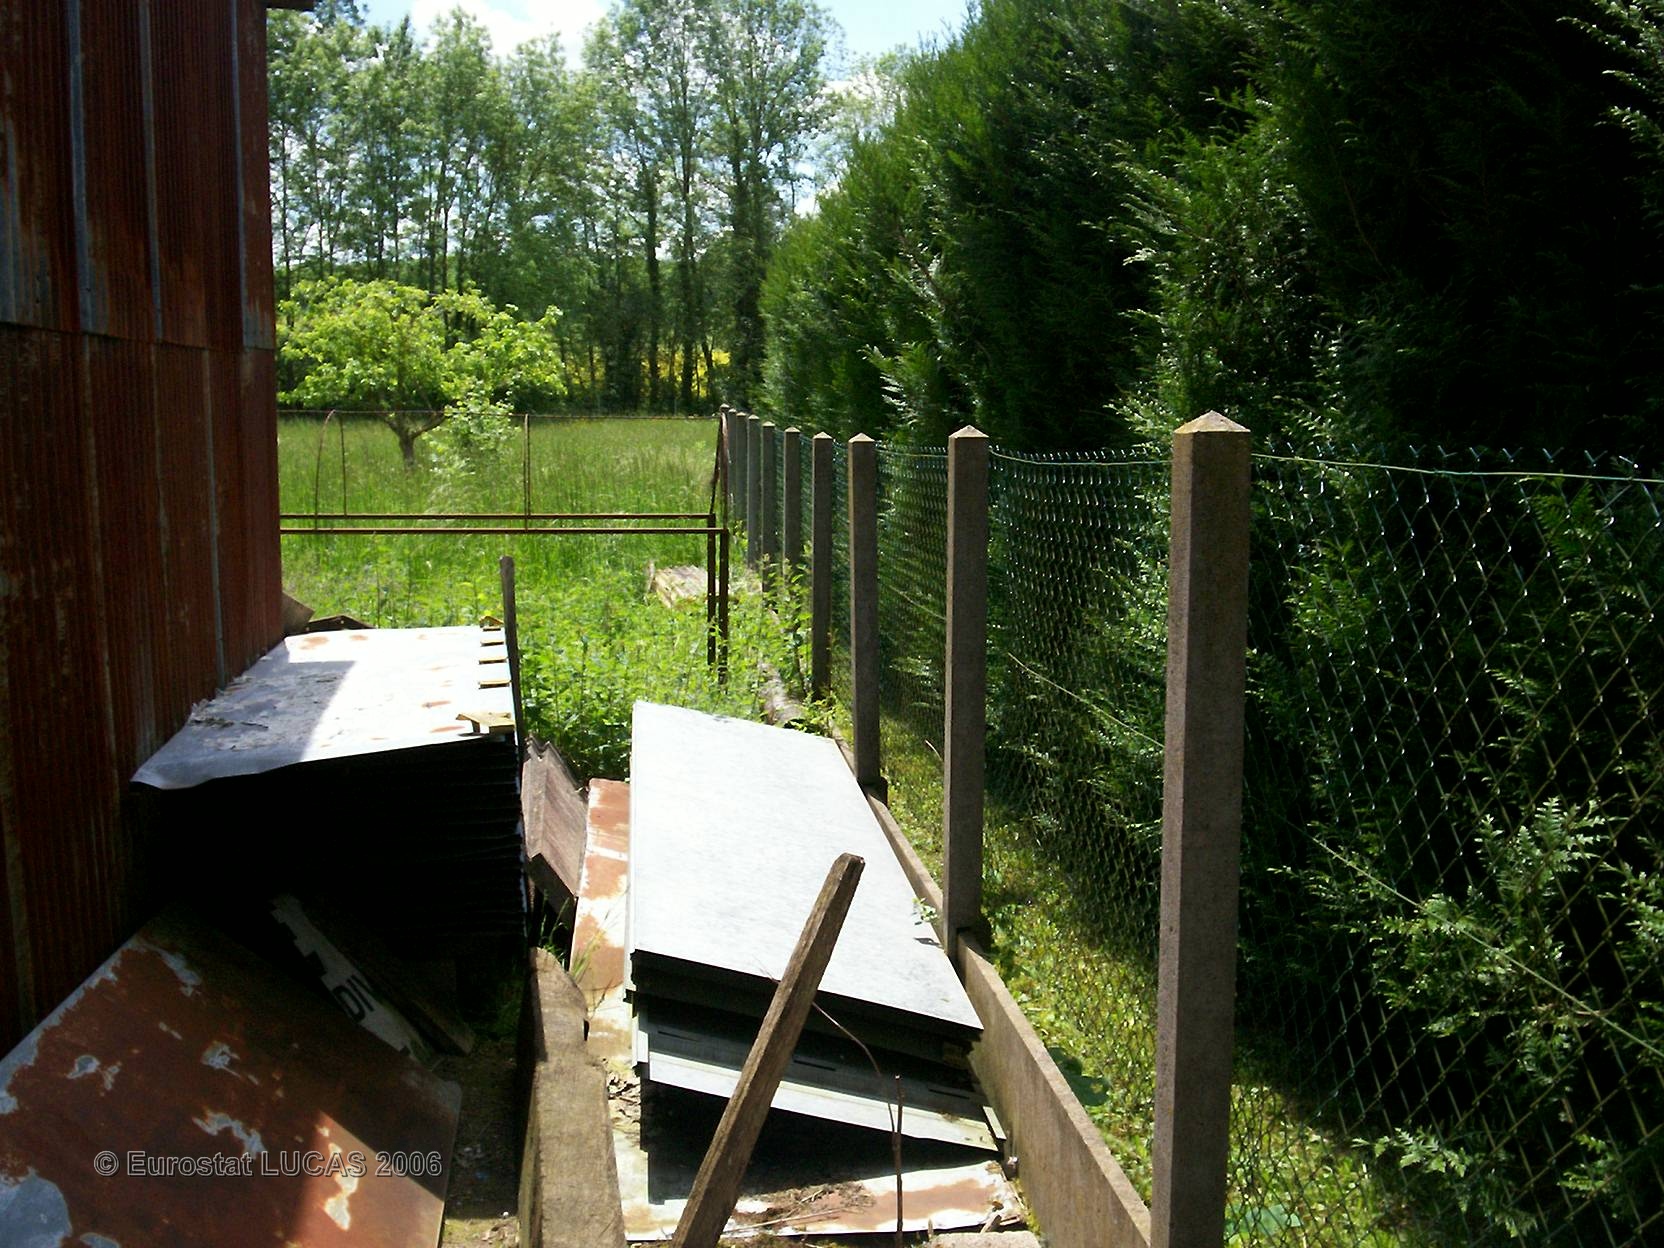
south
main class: Grassland
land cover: Grassland with sparse tree/shrub cover
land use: Residential
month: March
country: FR
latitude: 48.1431
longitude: 4.5548
